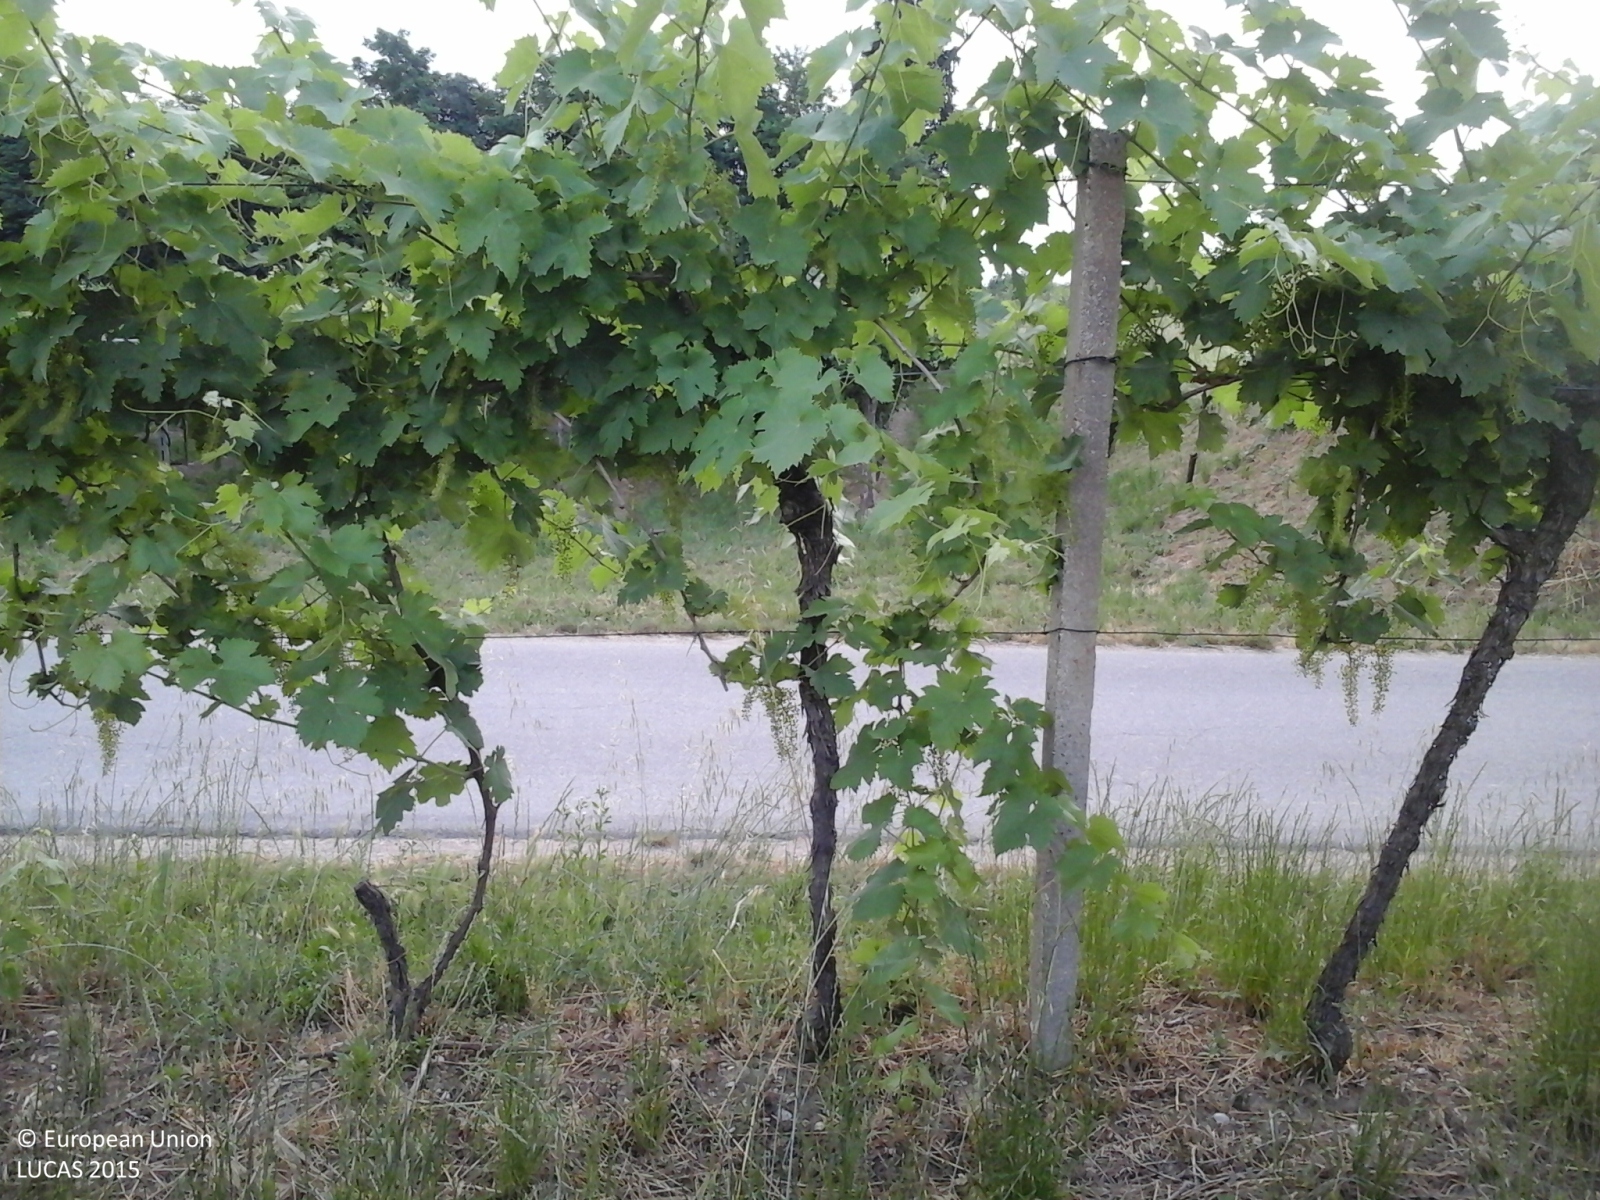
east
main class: Cropland
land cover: Vineyards
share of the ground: 25 - 50 %
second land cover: Grassland without tree/shrub cover
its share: > 75 %
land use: Agriculture (excluding fallow land and kitchen gardens)
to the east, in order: Vineyards; Grassland without tree/shrub cover; Grass margins; Paved roads, cycling and walking lanes; Grass margins; Vineyards; Managed hedges; Maize; Grassland without tree/shrub cover; Maize; Grass margins; Paved roads, cycling and walking lanes; Grass margins; Maize; Fences; Paved roads, cycling and walking lanes; Fences; Managed hedges
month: June
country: IT
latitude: 45.4477
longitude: 10.7531
